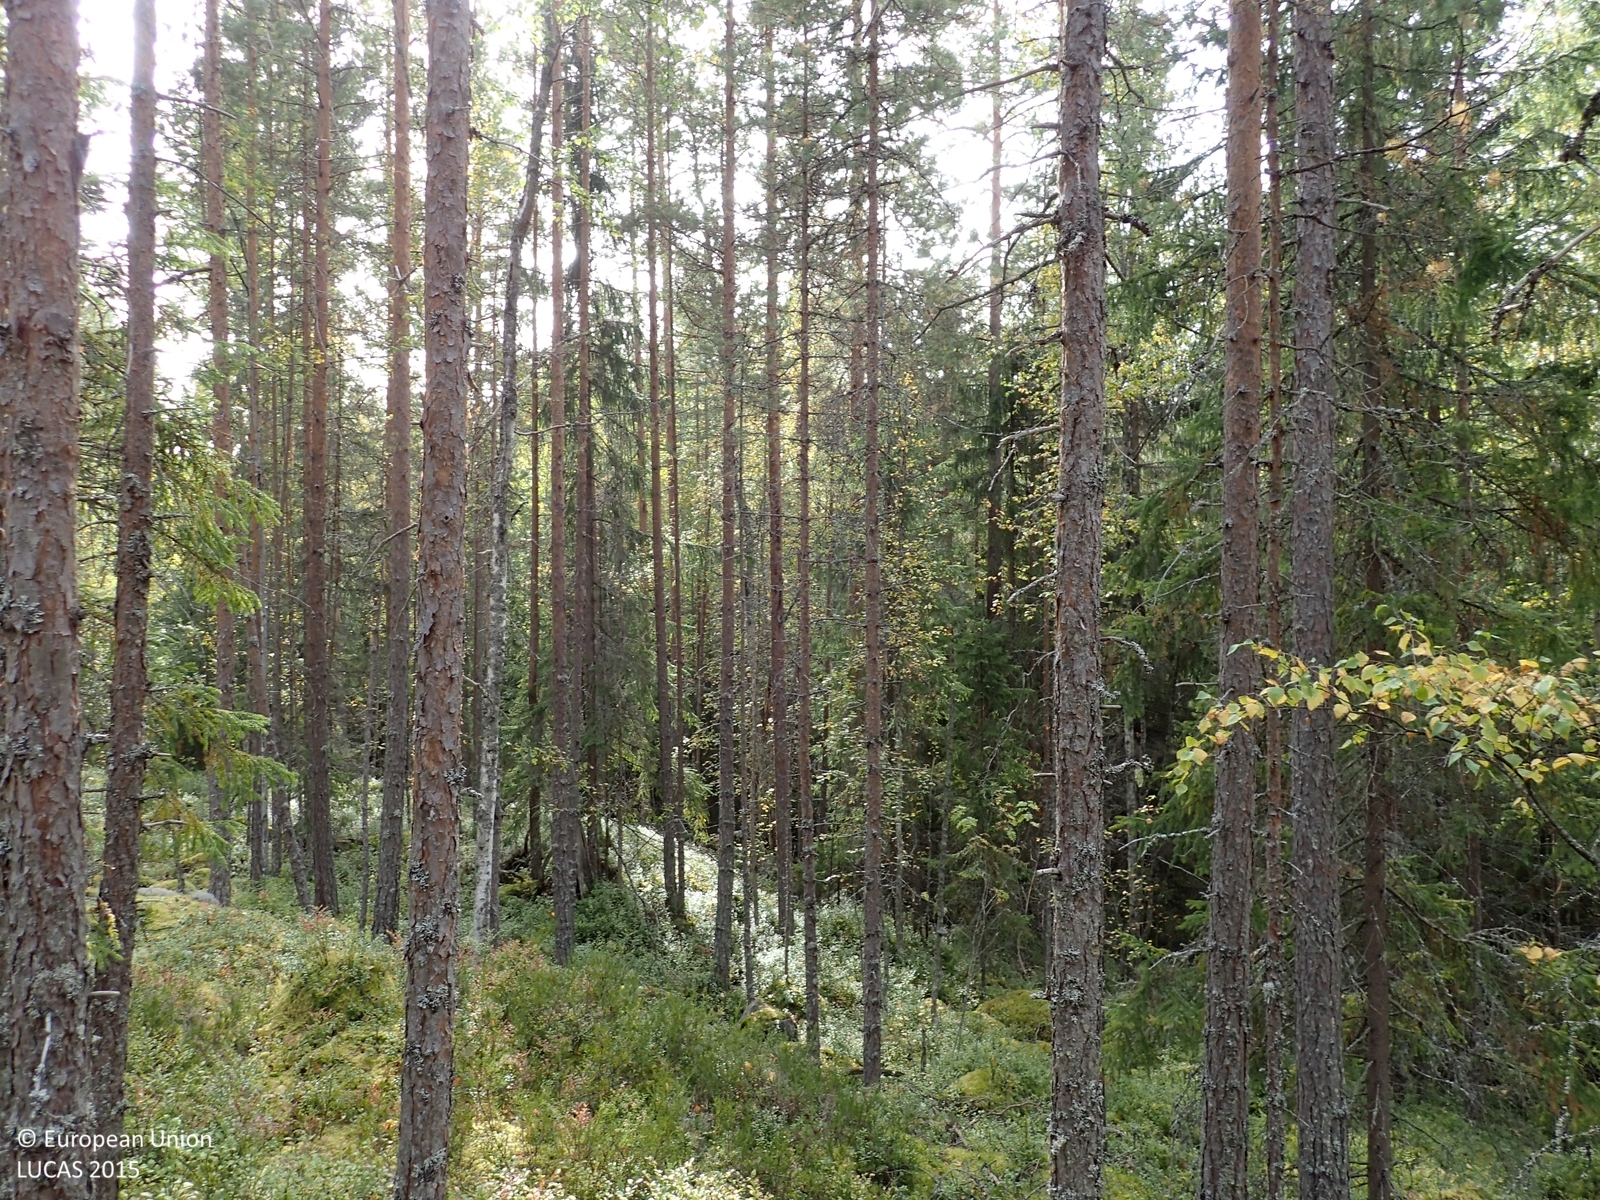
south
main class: Woodland
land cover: Pine dominated coniferous woodland
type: boreal forest
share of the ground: 50 - 75 %
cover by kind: coniferous forest trees 70 %, shrubs 25 %, lichens and mosses 5 %
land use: Forestry
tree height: > 5 m
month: September
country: FI
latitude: 63.0693
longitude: 25.1993
